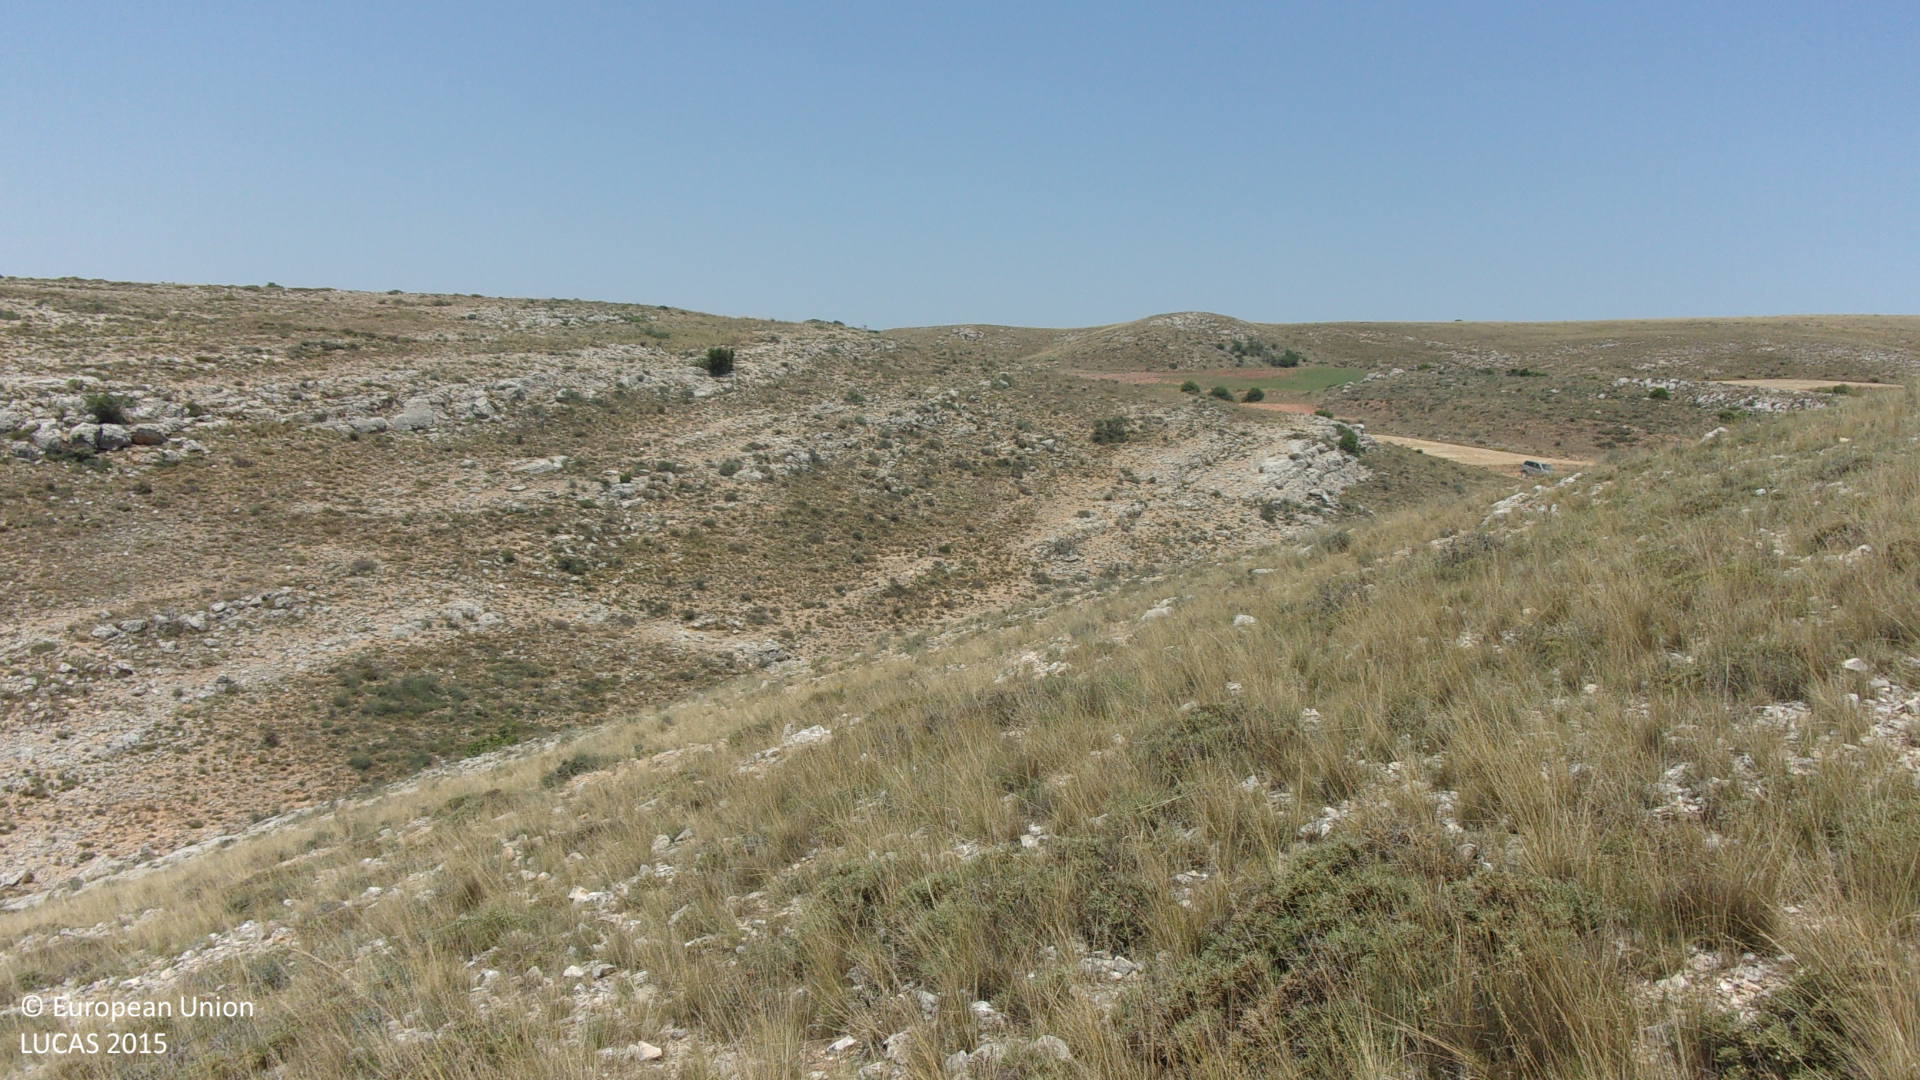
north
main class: Shrubland
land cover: Shrubland without tree cover
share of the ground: > 75 %
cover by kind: shrubs 65 %, consolidated bare surface 20 %, herbaceous plants 15 %
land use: Semi-natural and natural areas not in use
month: July
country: ES
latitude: 41.5830
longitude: -1.9171
